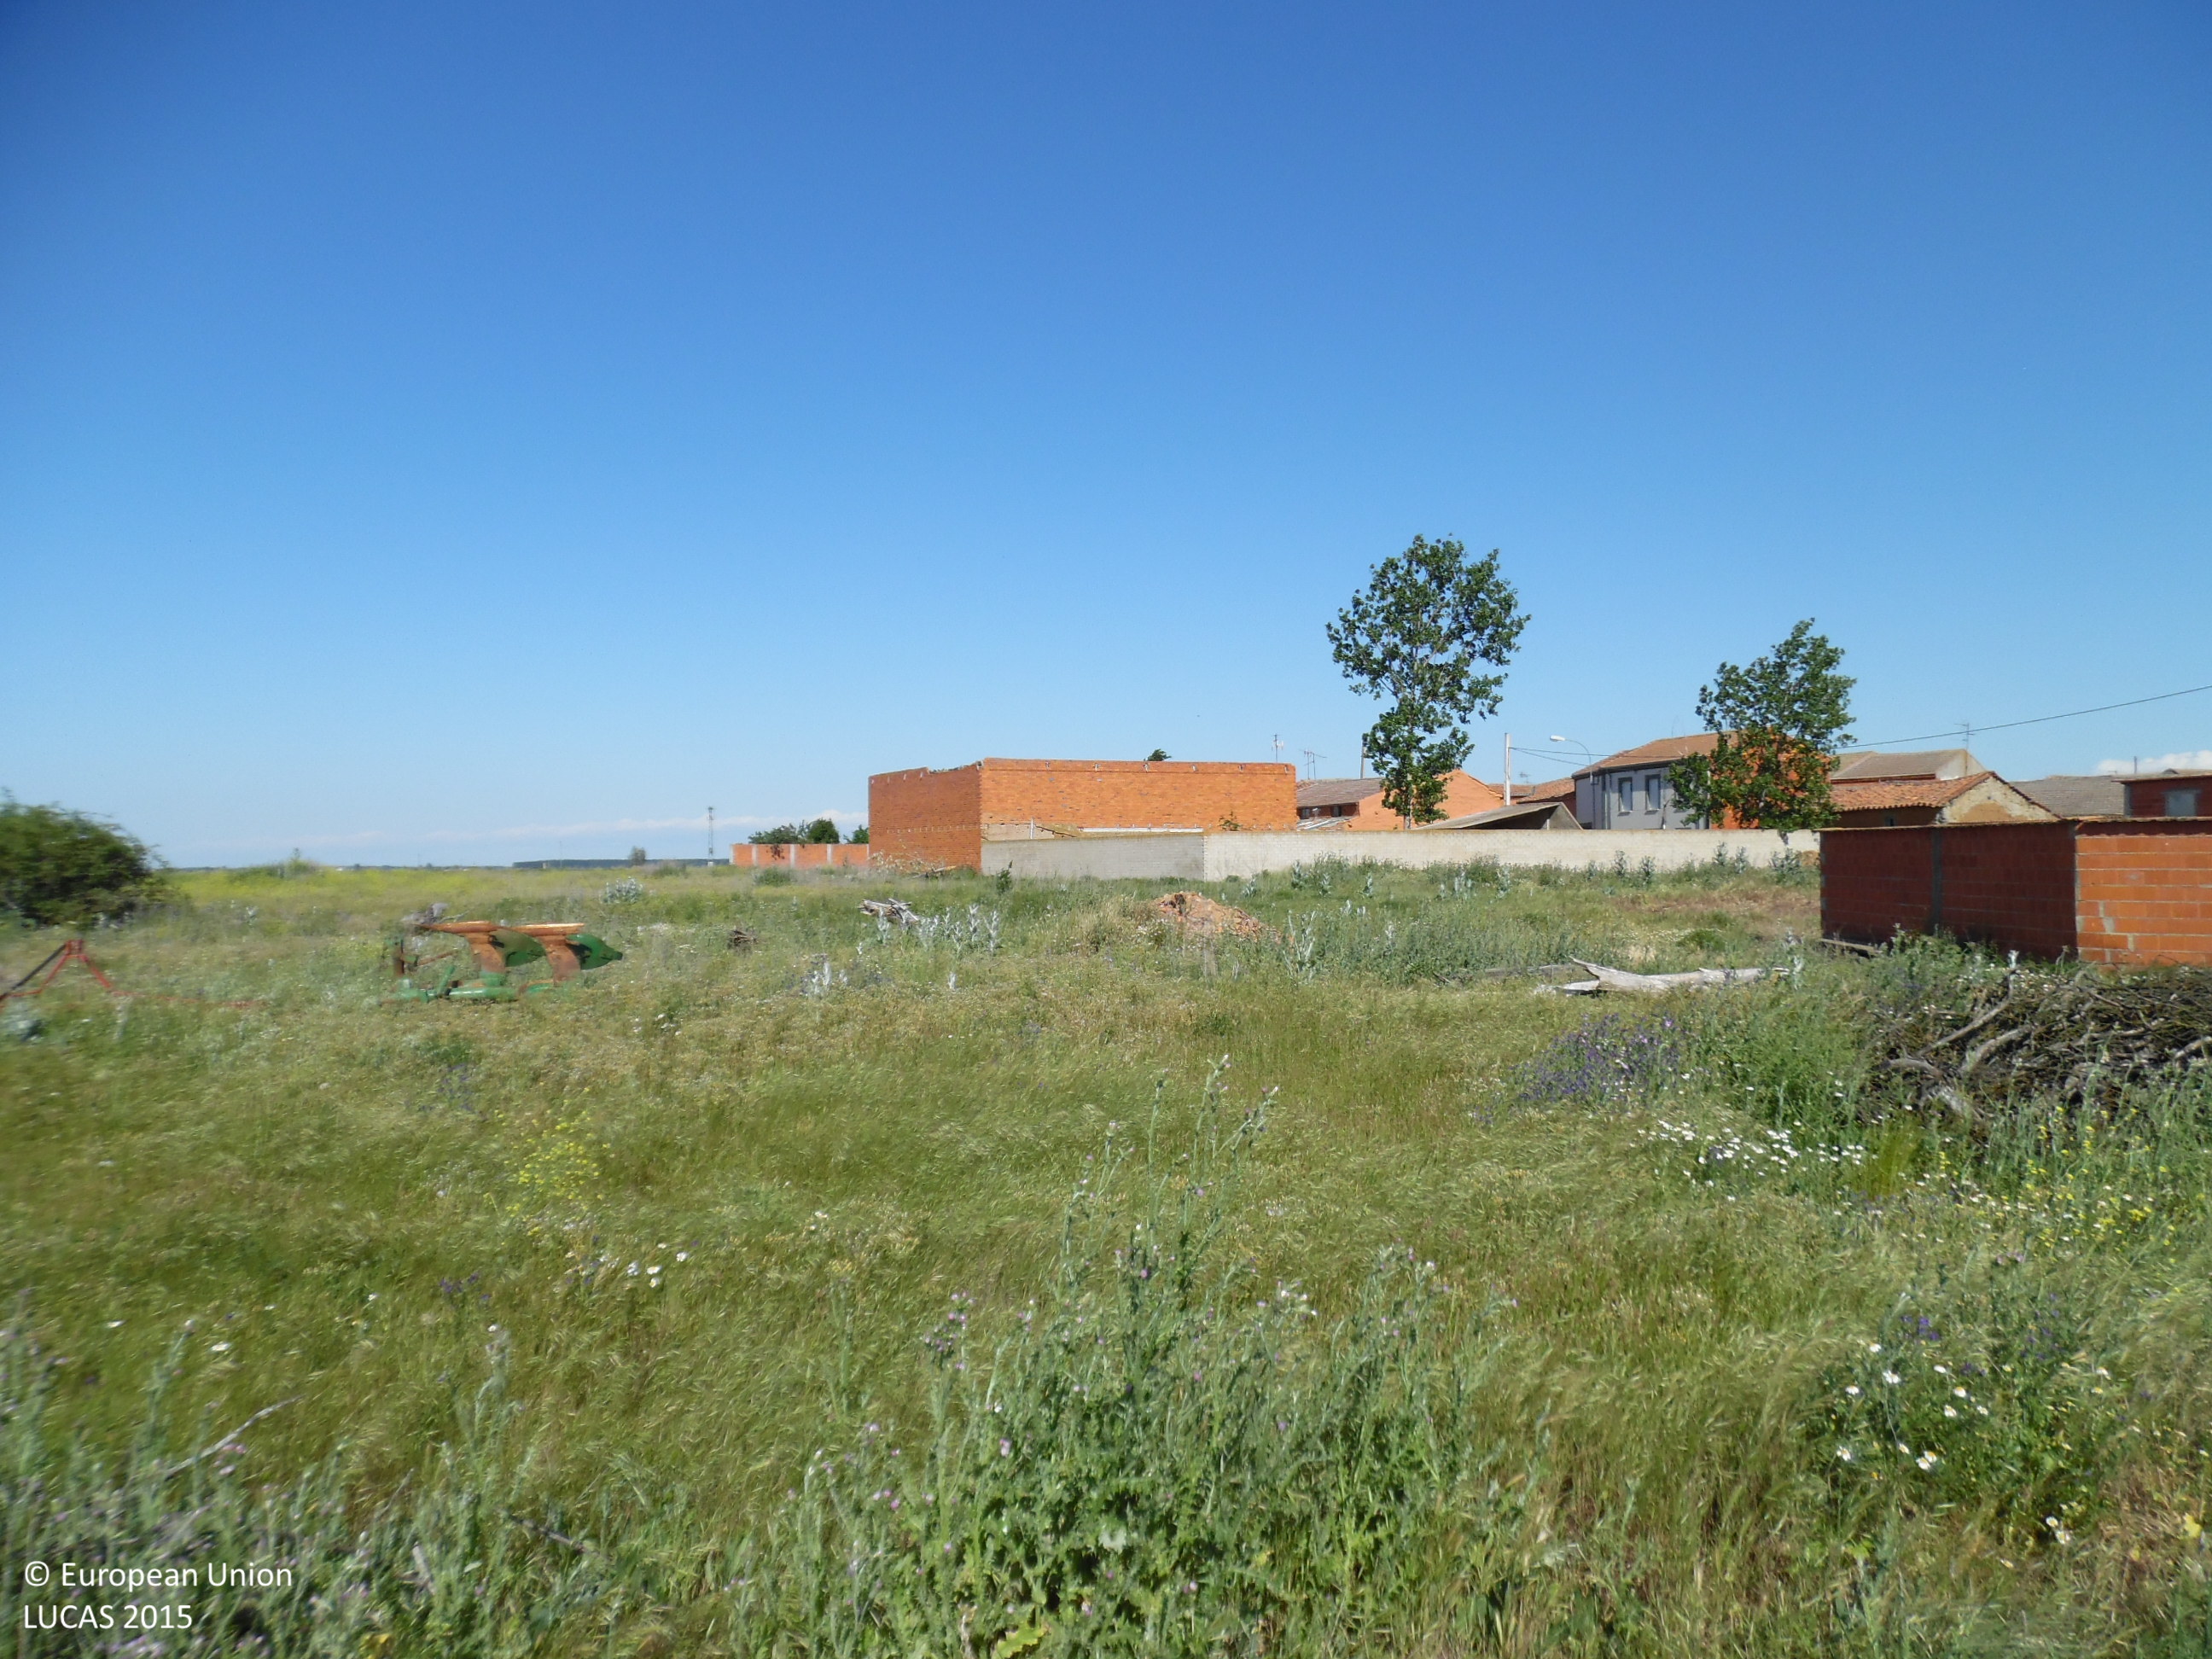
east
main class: Grassland
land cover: Grassland without tree/shrub cover
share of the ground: > 75 %
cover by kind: herbaceous plants 95 %, shrubs 5 %
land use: Abandoned areas
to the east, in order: Grassland without tree/shrub cover; Artificial constructions in urban areas
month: May
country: ES
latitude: 42.2443
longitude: -5.7175
